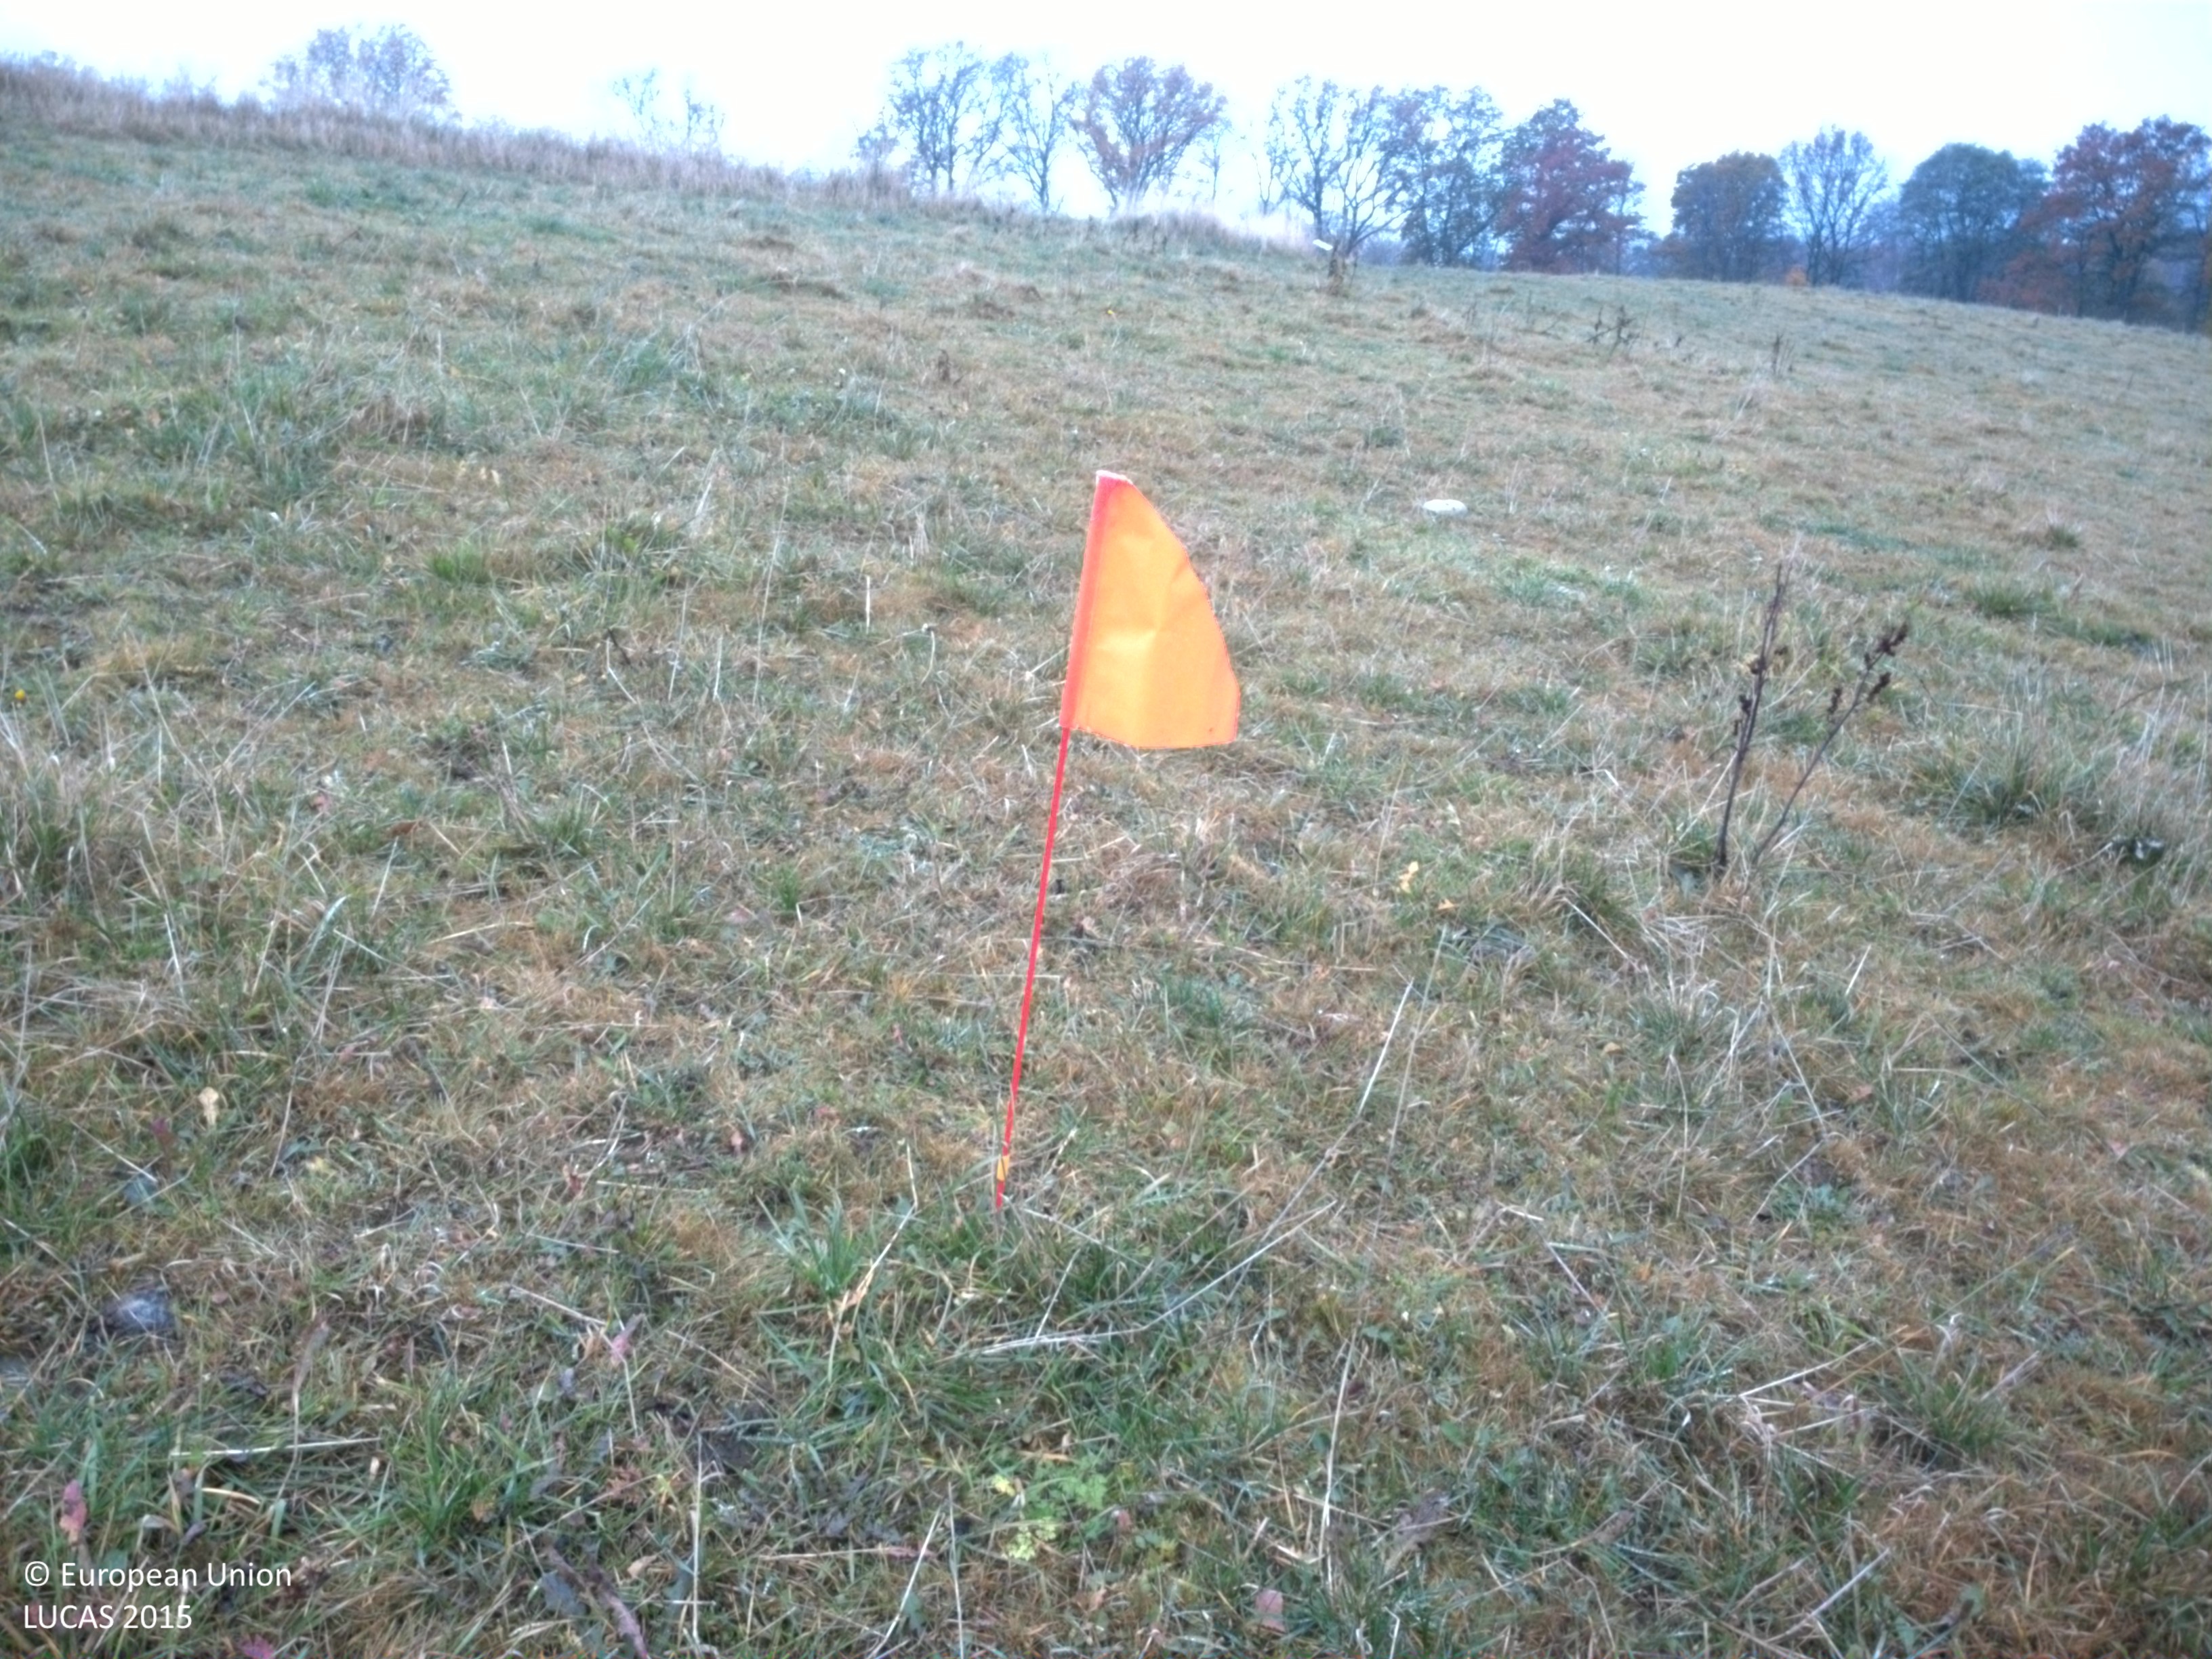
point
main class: Grassland
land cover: Grassland without tree/shrub cover
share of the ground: > 75 %
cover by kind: herbaceous plants 100 %
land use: Agriculture (excluding fallow land and kitchen gardens)
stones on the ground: < 10 %
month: November
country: SE
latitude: 56.0433
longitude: 13.0636
